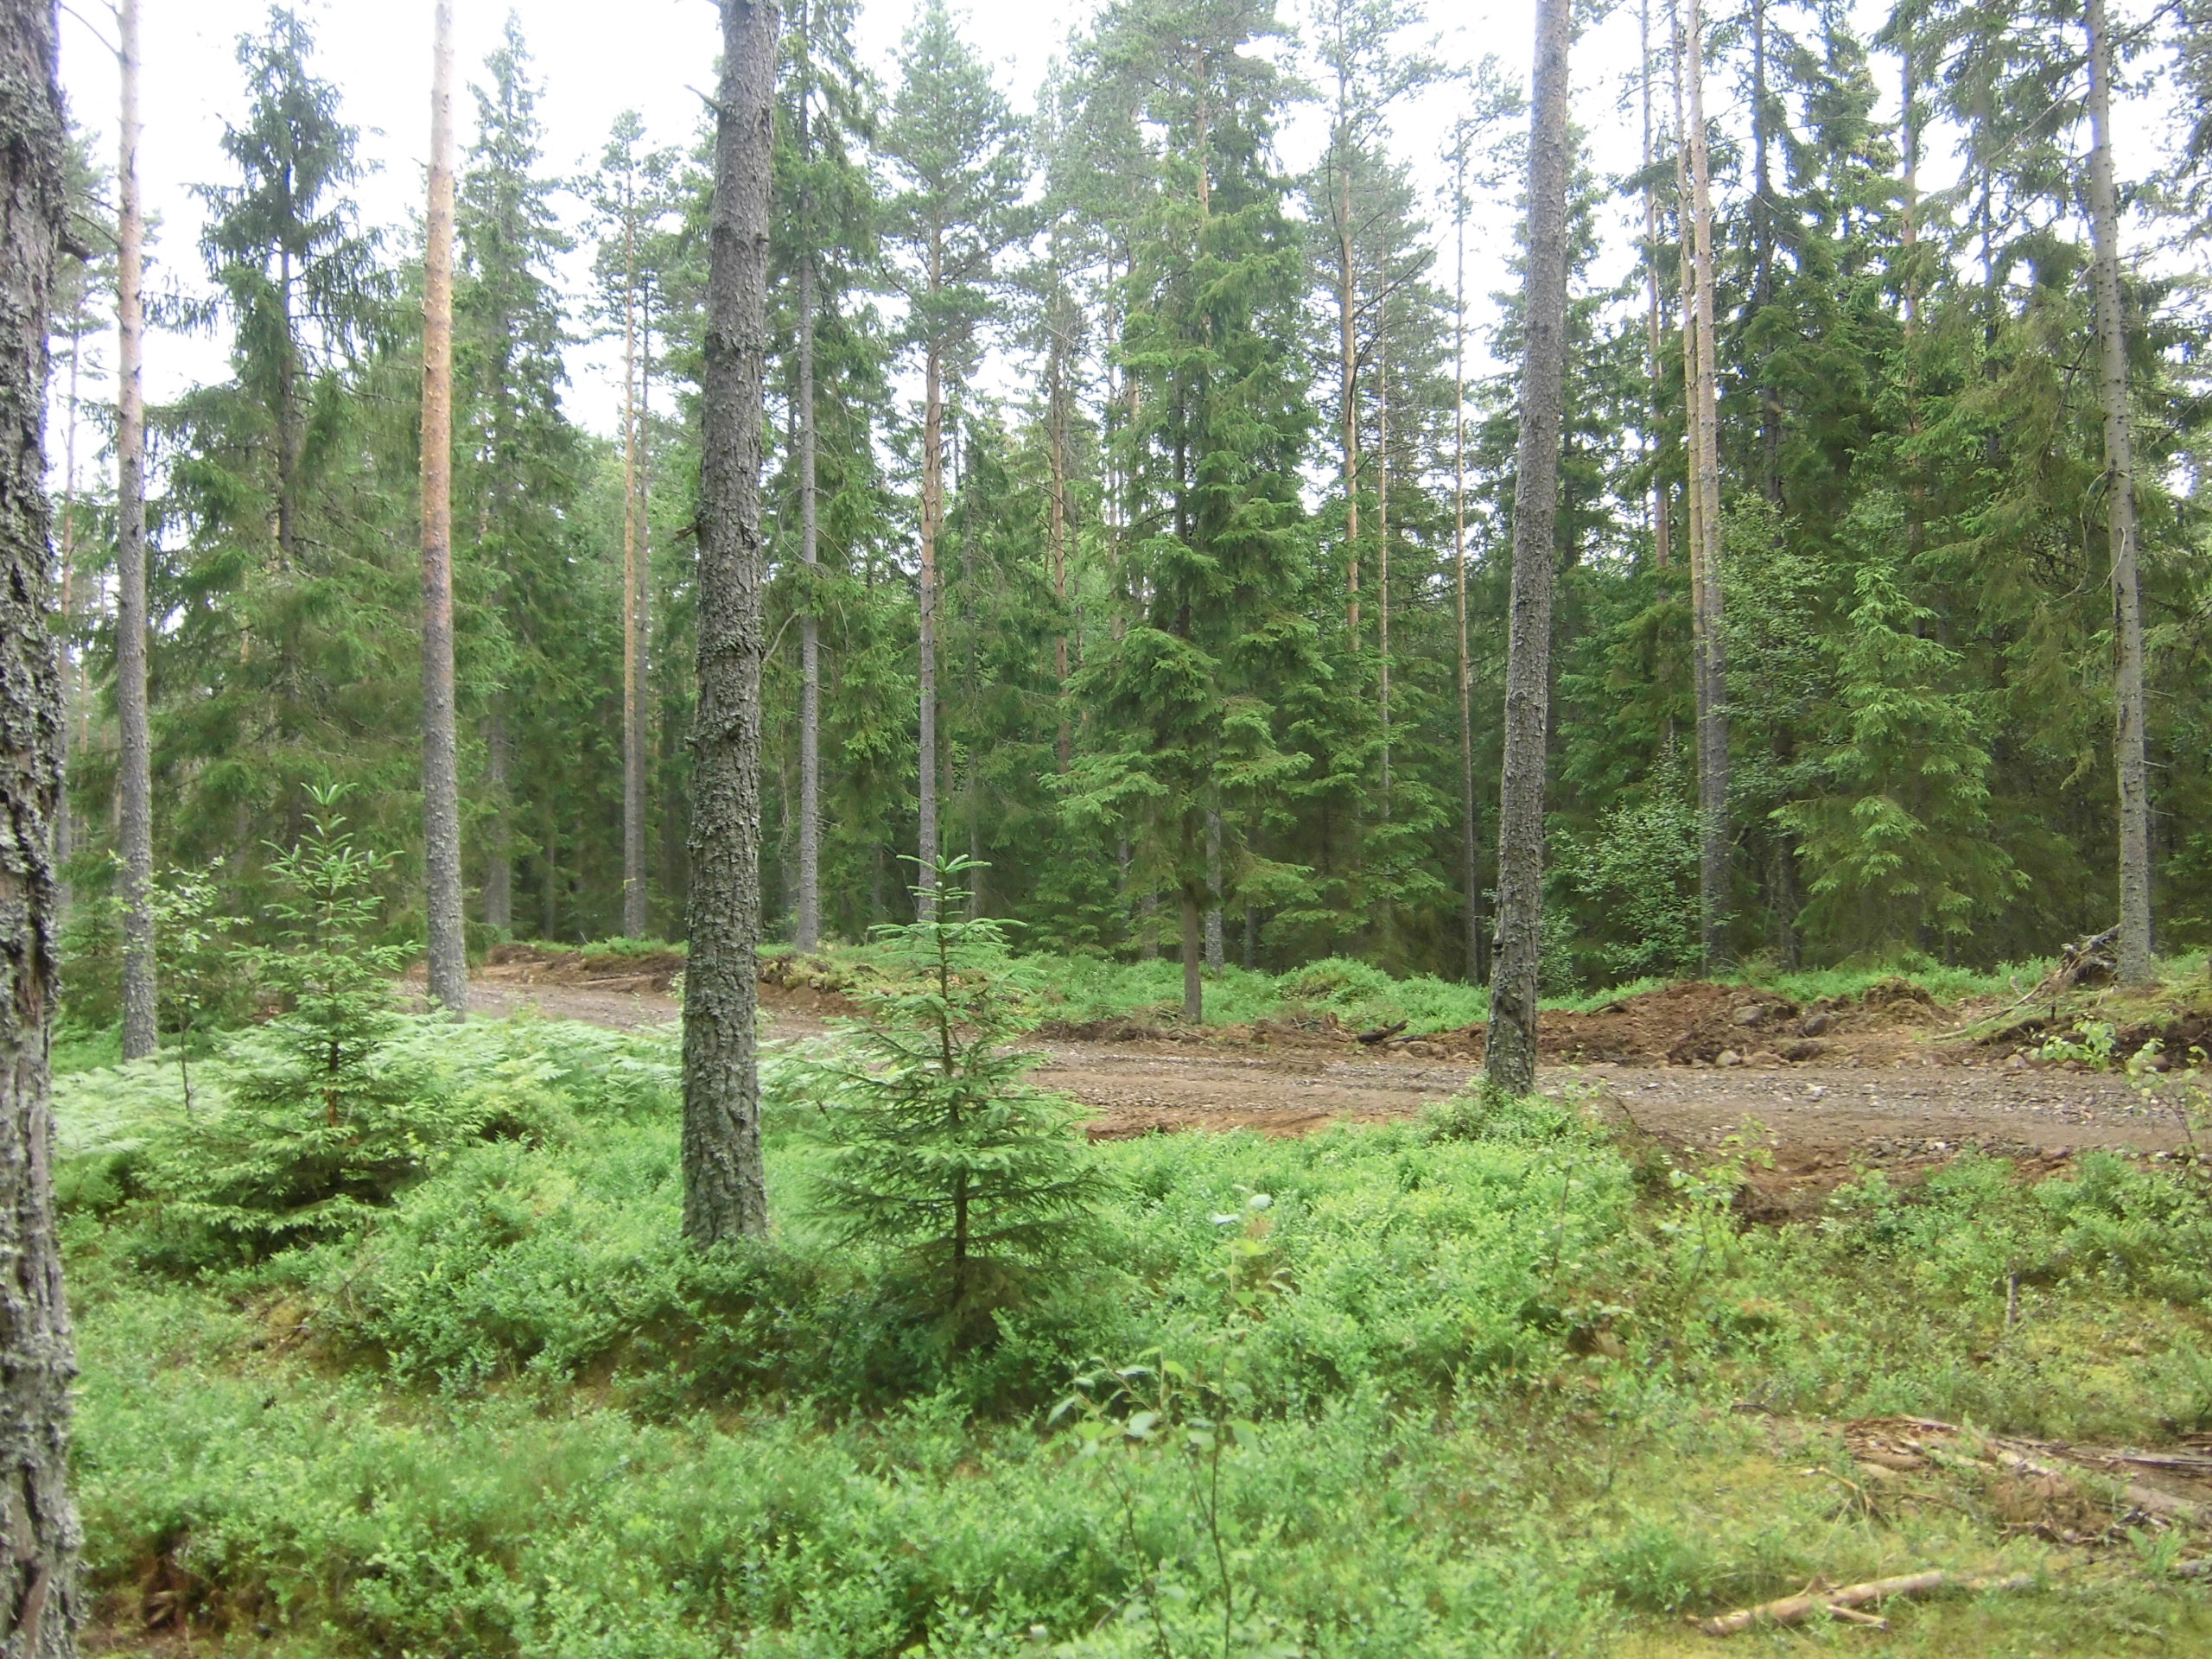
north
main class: Woodland
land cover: Pine dominated coniferous woodland
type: boreal forest
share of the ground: 25 - 50 %
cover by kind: coniferous forest trees 45 %, shrubs 25 %, lichens and mosses 15 %, herbaceous plants 10 %, broadleaved forest trees 5 %
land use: Forestry
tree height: > 5 m
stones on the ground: 10 - 25 %
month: July
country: SE
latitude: 57.3183
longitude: 14.9280
